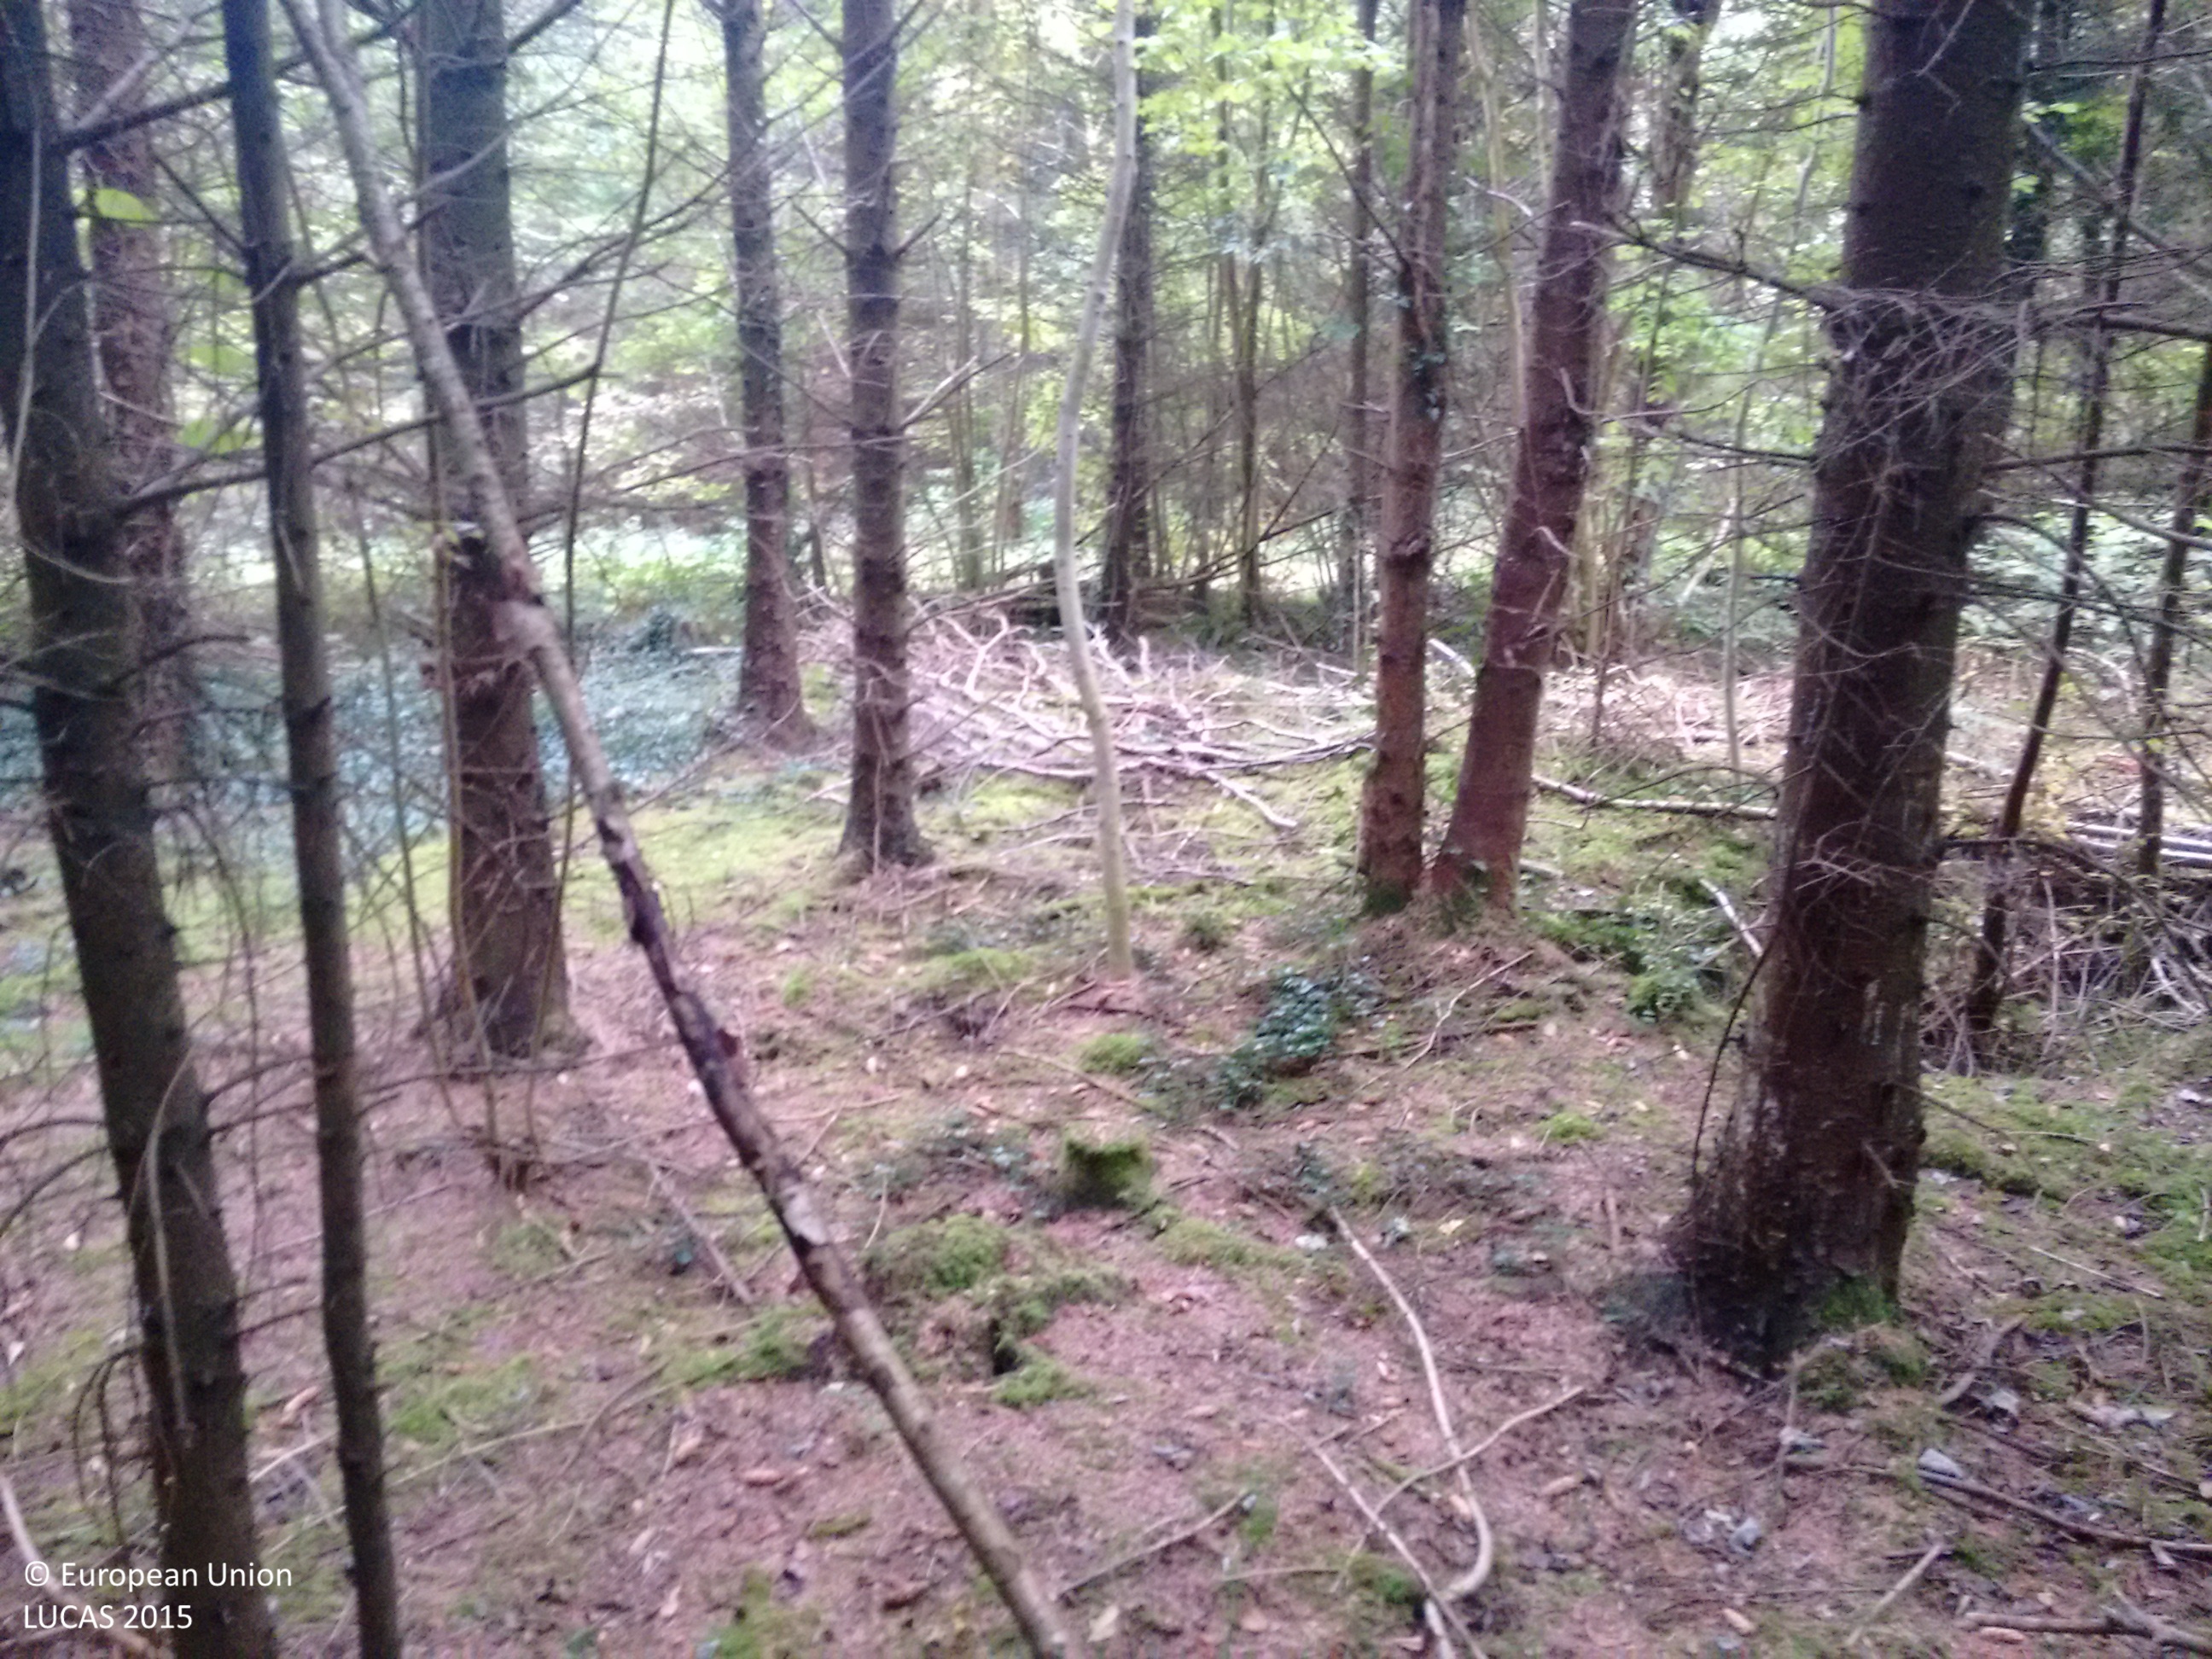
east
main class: Woodland
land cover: Spruce dominated mixed woodland
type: exotic forest
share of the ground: > 75 %
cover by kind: coniferous forest trees 75 %, broadleaved forest trees 25 %
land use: Forestry
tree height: > 5 m
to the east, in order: Spruce dominated mixed woodland; Tracks; Spruce dominated mixed woodland; Other mixed woodland; Fences; Grassland without tree/shrub cover
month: October
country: IE
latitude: 52.8427
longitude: -7.4228
